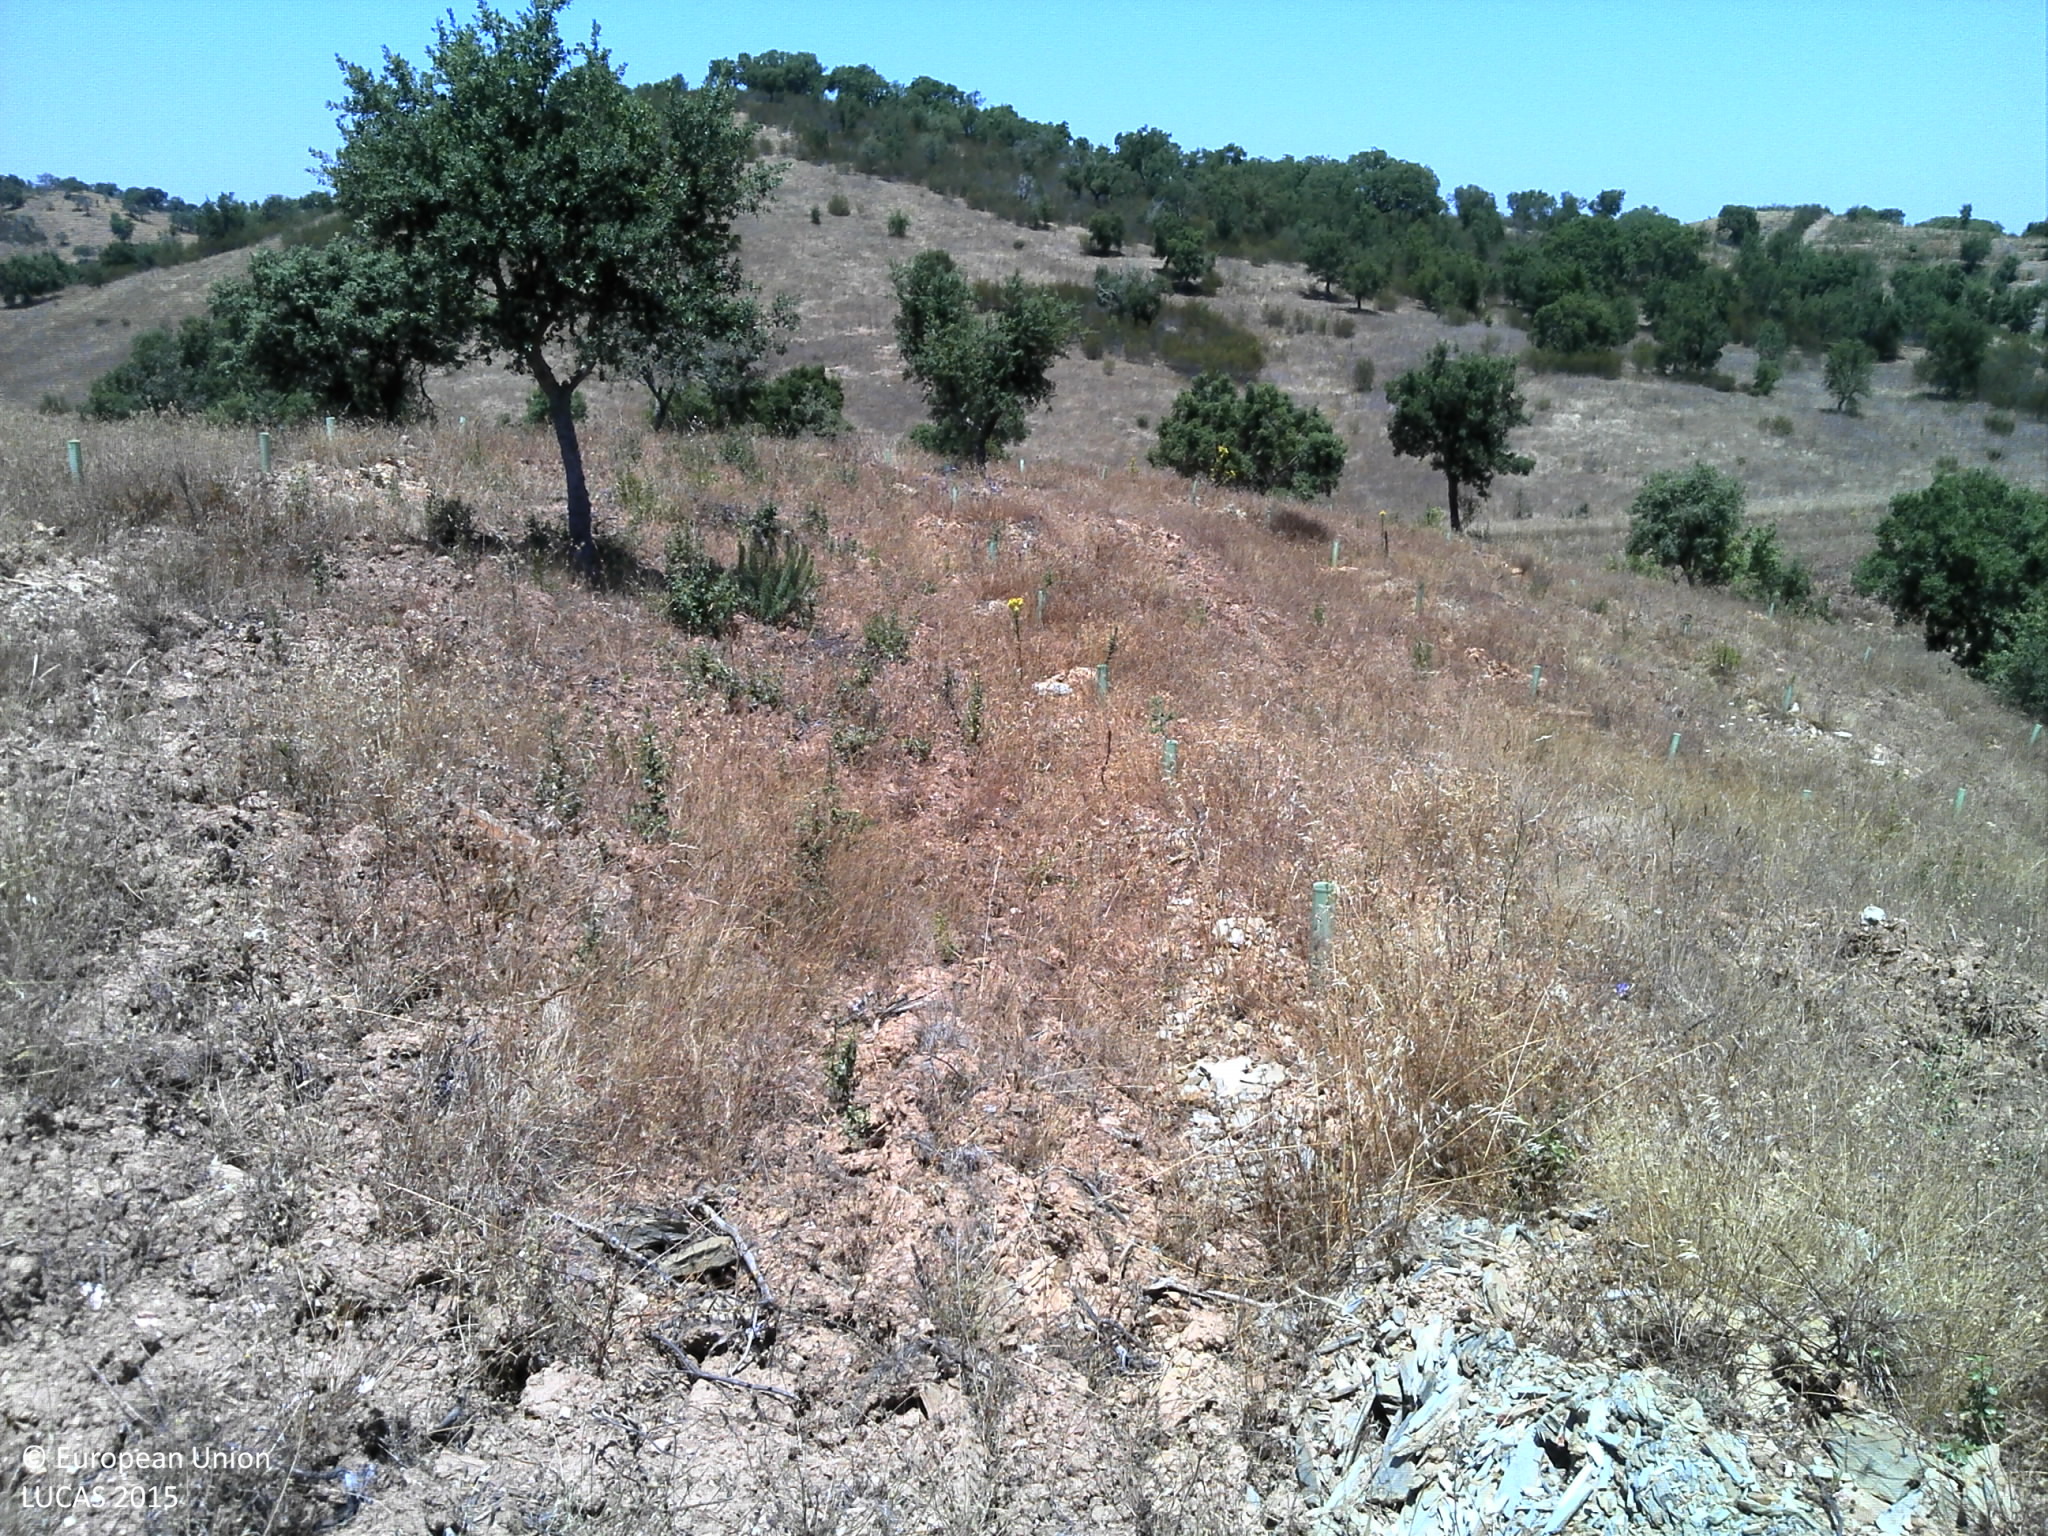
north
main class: Grassland
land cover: Grassland with sparse tree/shrub cover
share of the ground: 25 - 50 %
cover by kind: herbaceous plants 50 %, unconsolidated bare surface 45 %, broadleaved forest trees 5 %
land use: Forestry
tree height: < 5 m
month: June
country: PT
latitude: 37.7141
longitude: -8.4936
